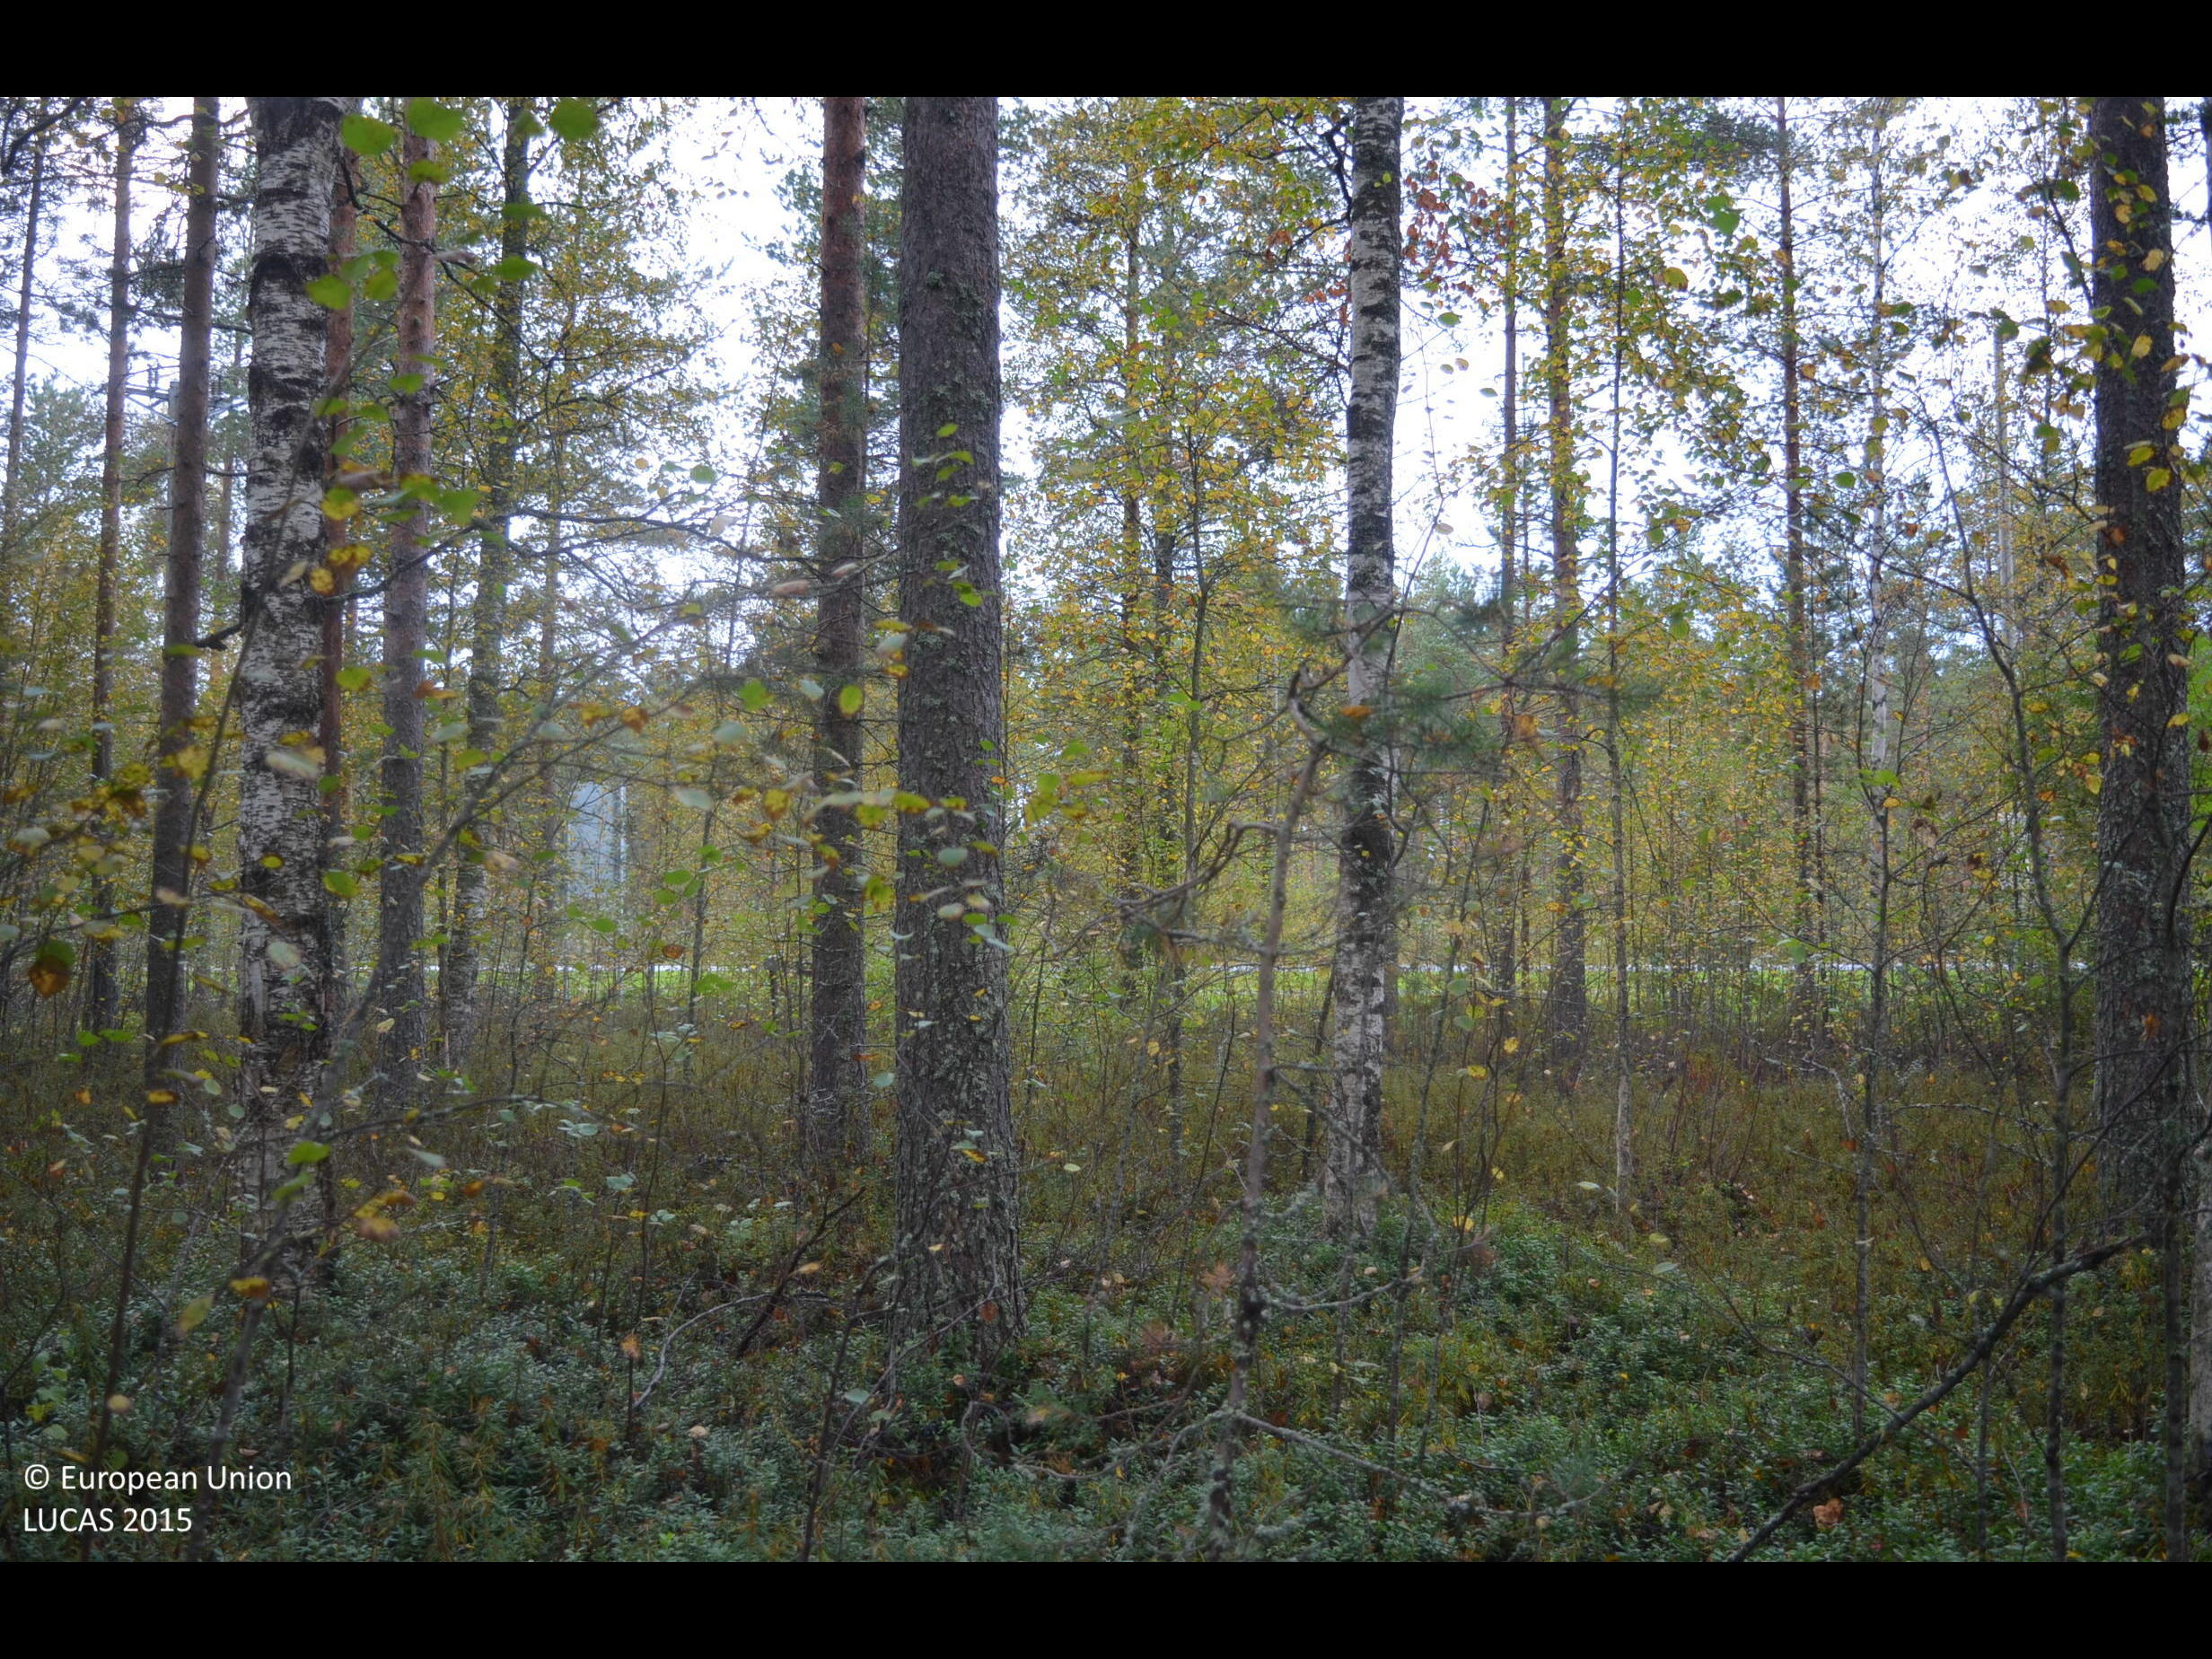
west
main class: Woodland
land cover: Pine dominated mixed woodland
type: boreal forest
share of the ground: > 75 %
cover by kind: broadleaved forest trees 40 %, coniferous forest trees 35 %, shrubs 25 %
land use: Forestry
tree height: > 5 m
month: September
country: FI
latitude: 63.0017
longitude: 23.7943
